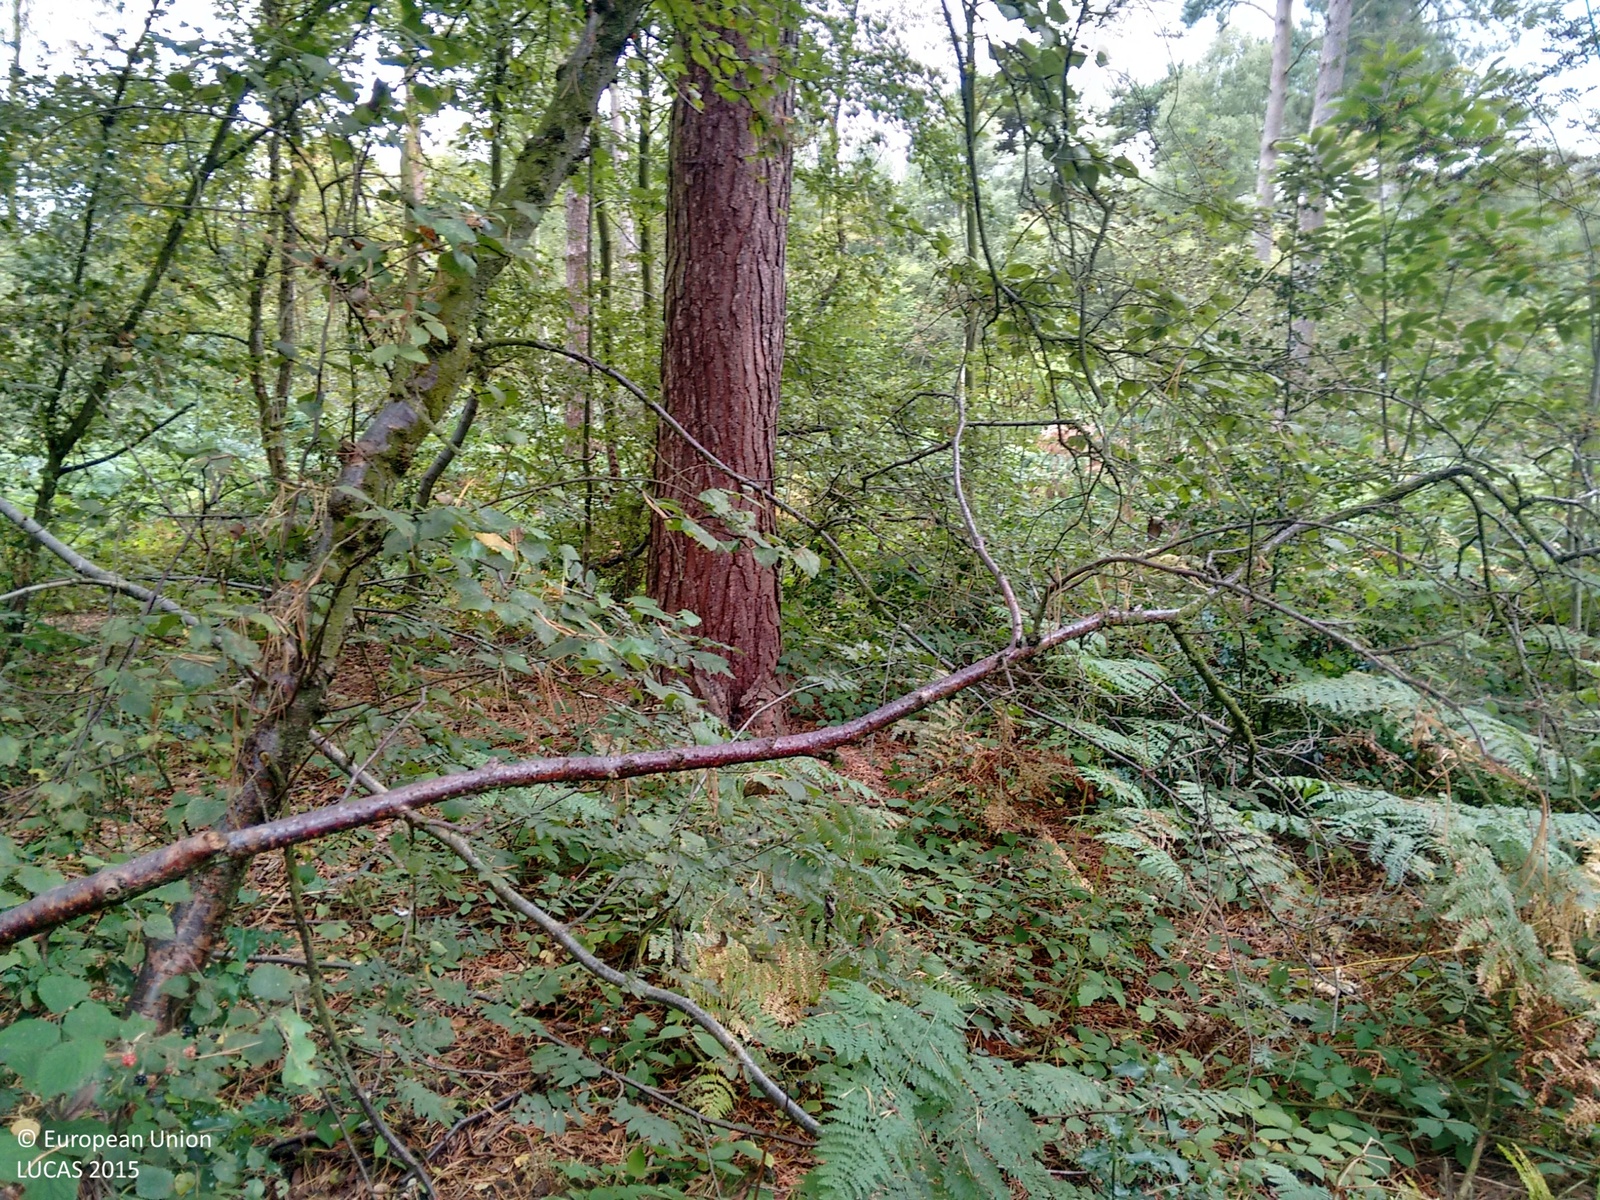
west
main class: Woodland
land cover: Broadleaved woodland
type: mesophytic deciduous forest
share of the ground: > 75 %
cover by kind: broadleaved forest trees 95 %, shrubs 5 %
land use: Amenities, museums, leisure
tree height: > 5 m
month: September
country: GB
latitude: 52.7084
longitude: -2.0326
